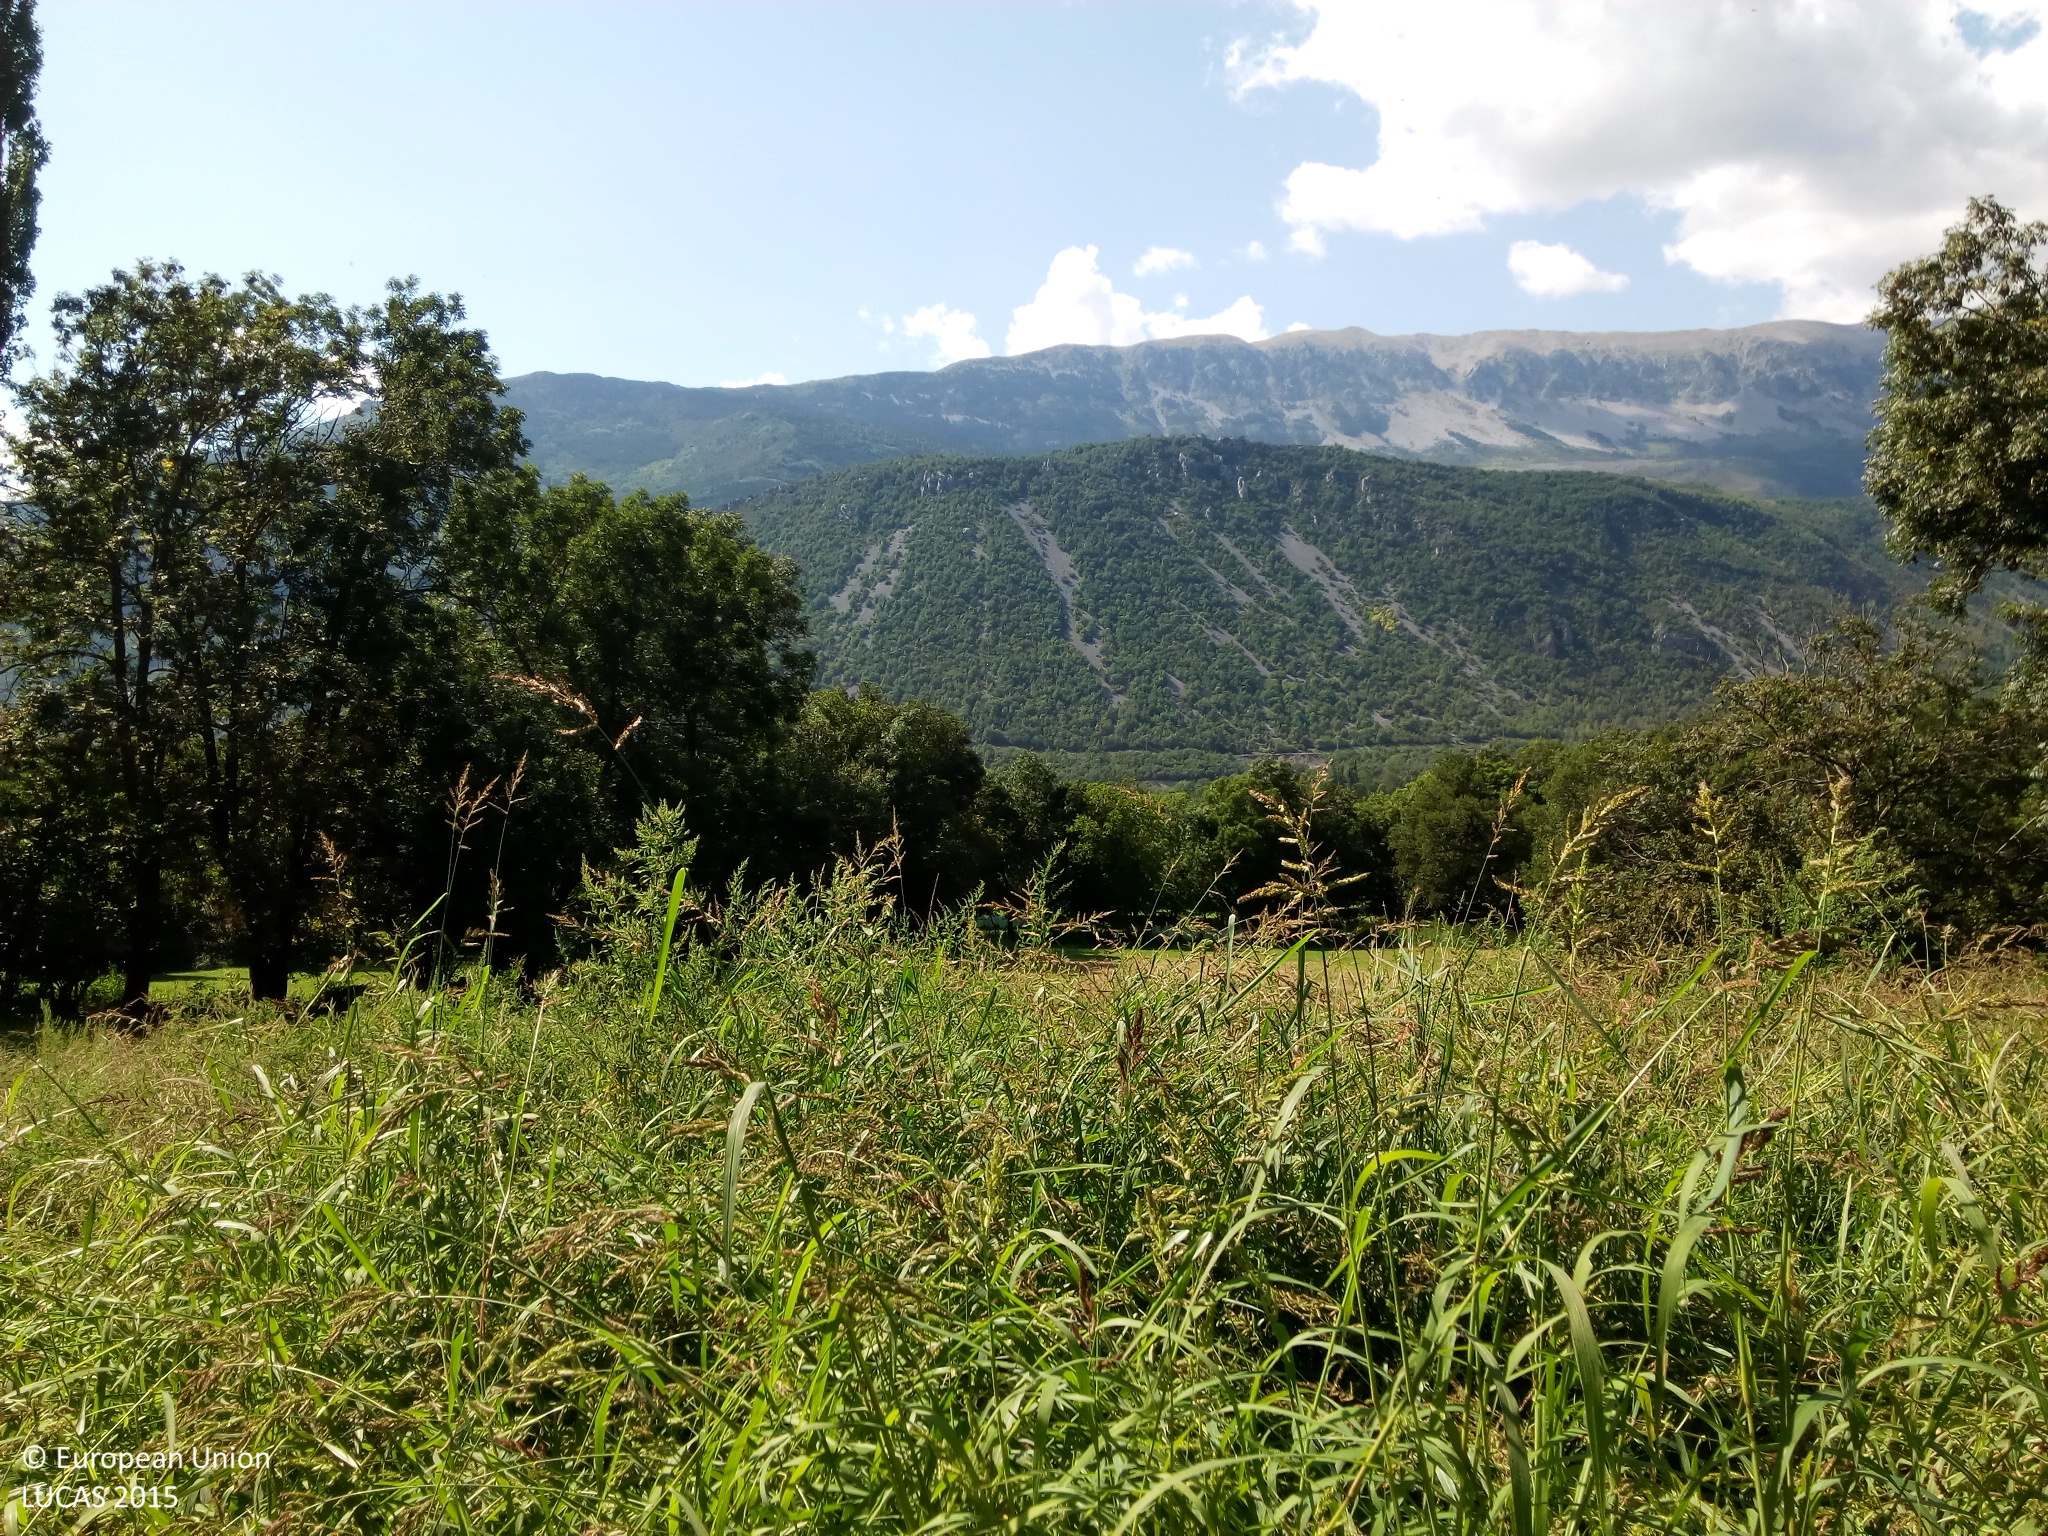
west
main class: Cropland
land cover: Other cereals
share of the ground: > 75 %
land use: Agriculture (excluding fallow land and kitchen gardens)
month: September
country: ES
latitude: 42.5154
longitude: 0.4986
